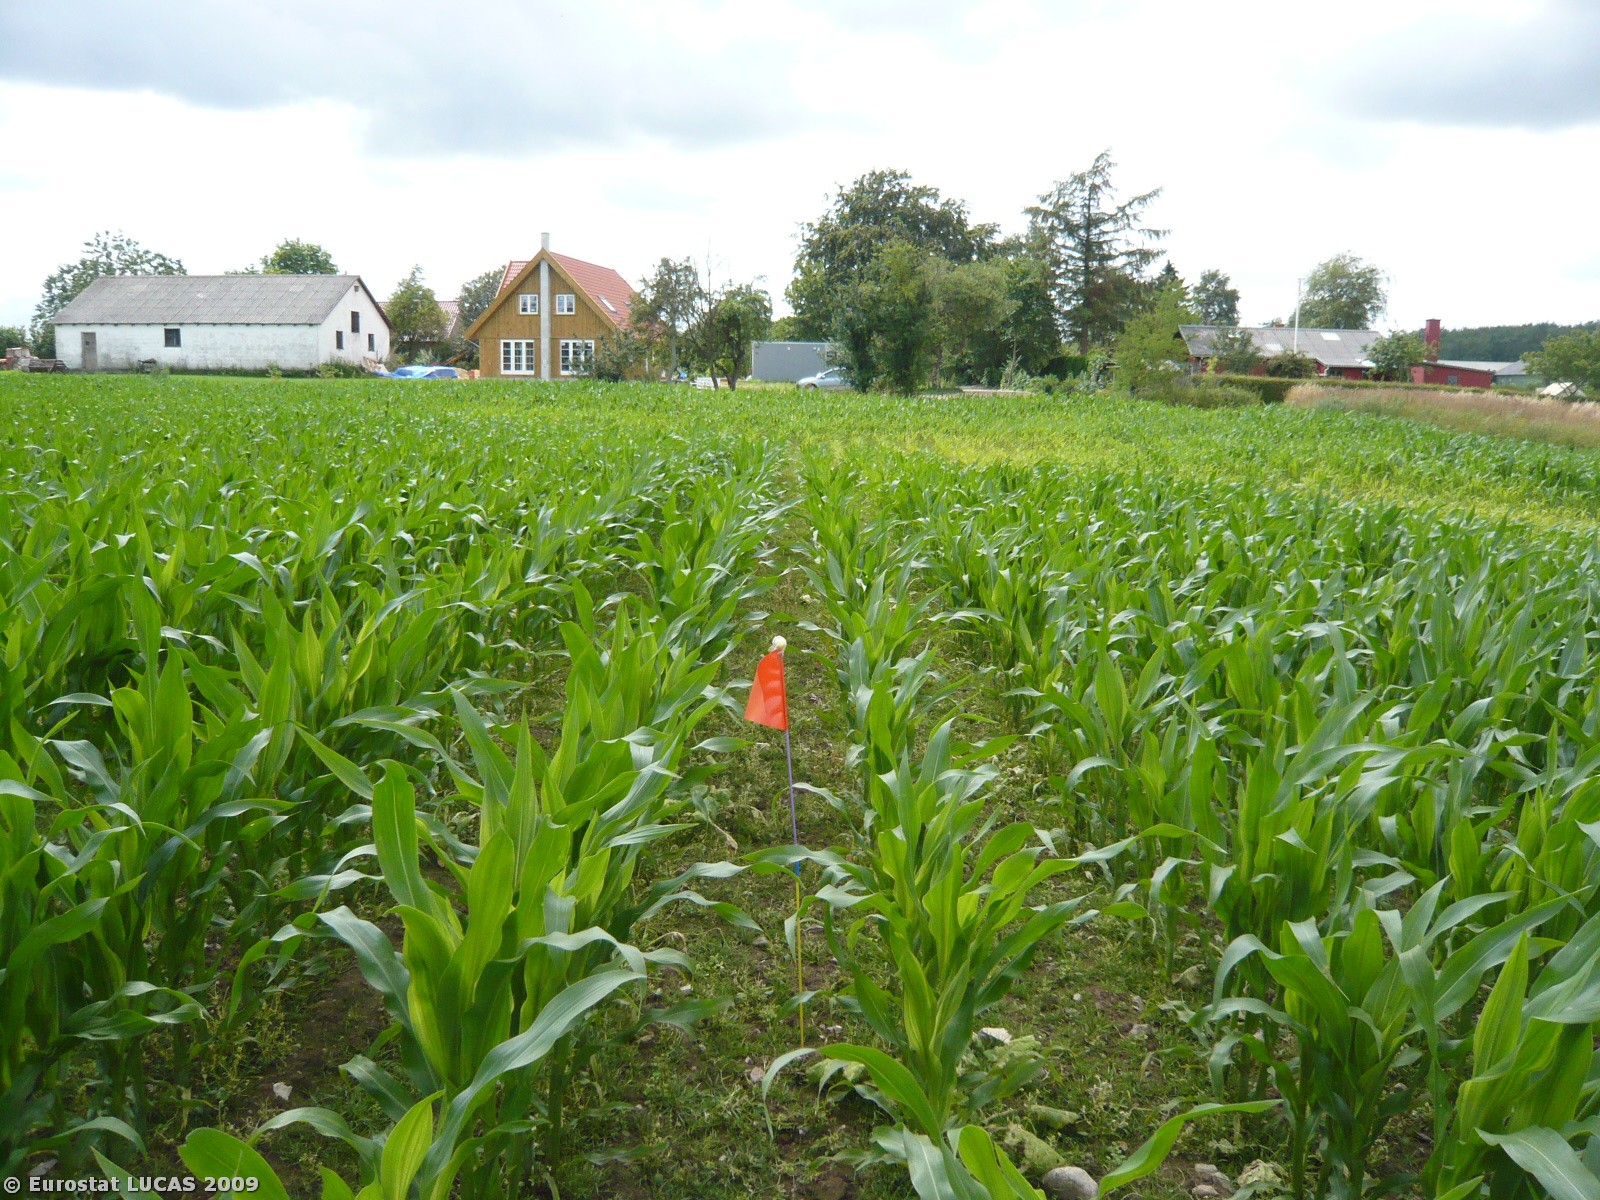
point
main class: Cropland
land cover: Maize
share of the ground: > 75 %
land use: Agriculture (excluding fallow land and kitchen gardens)
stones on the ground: < 10 %
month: July
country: DK
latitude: 55.5267
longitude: 11.8835
